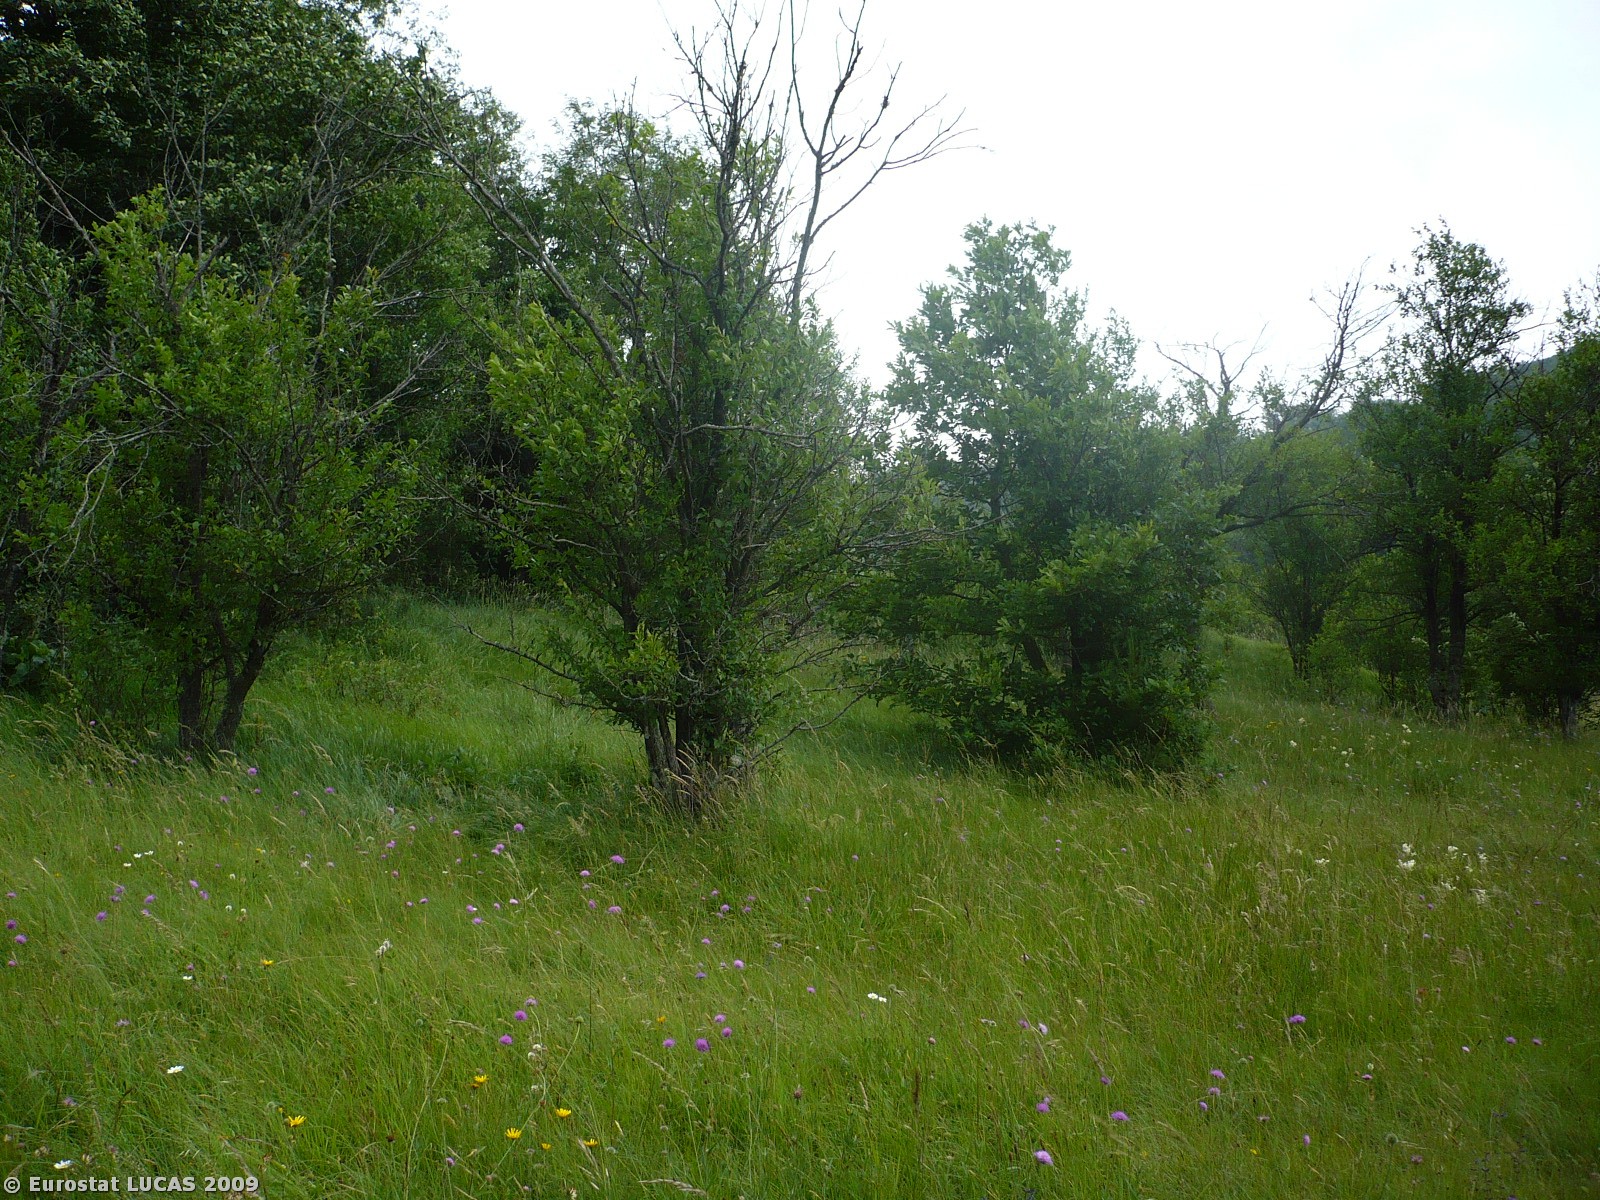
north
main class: Grassland
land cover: Grassland with sparse tree/shrub cover
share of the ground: > 75 %
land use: Agriculture (excluding fallow land and kitchen gardens)
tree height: > 5 m
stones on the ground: < 10 %
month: June
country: SI
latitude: 45.5088
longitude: 14.2576
